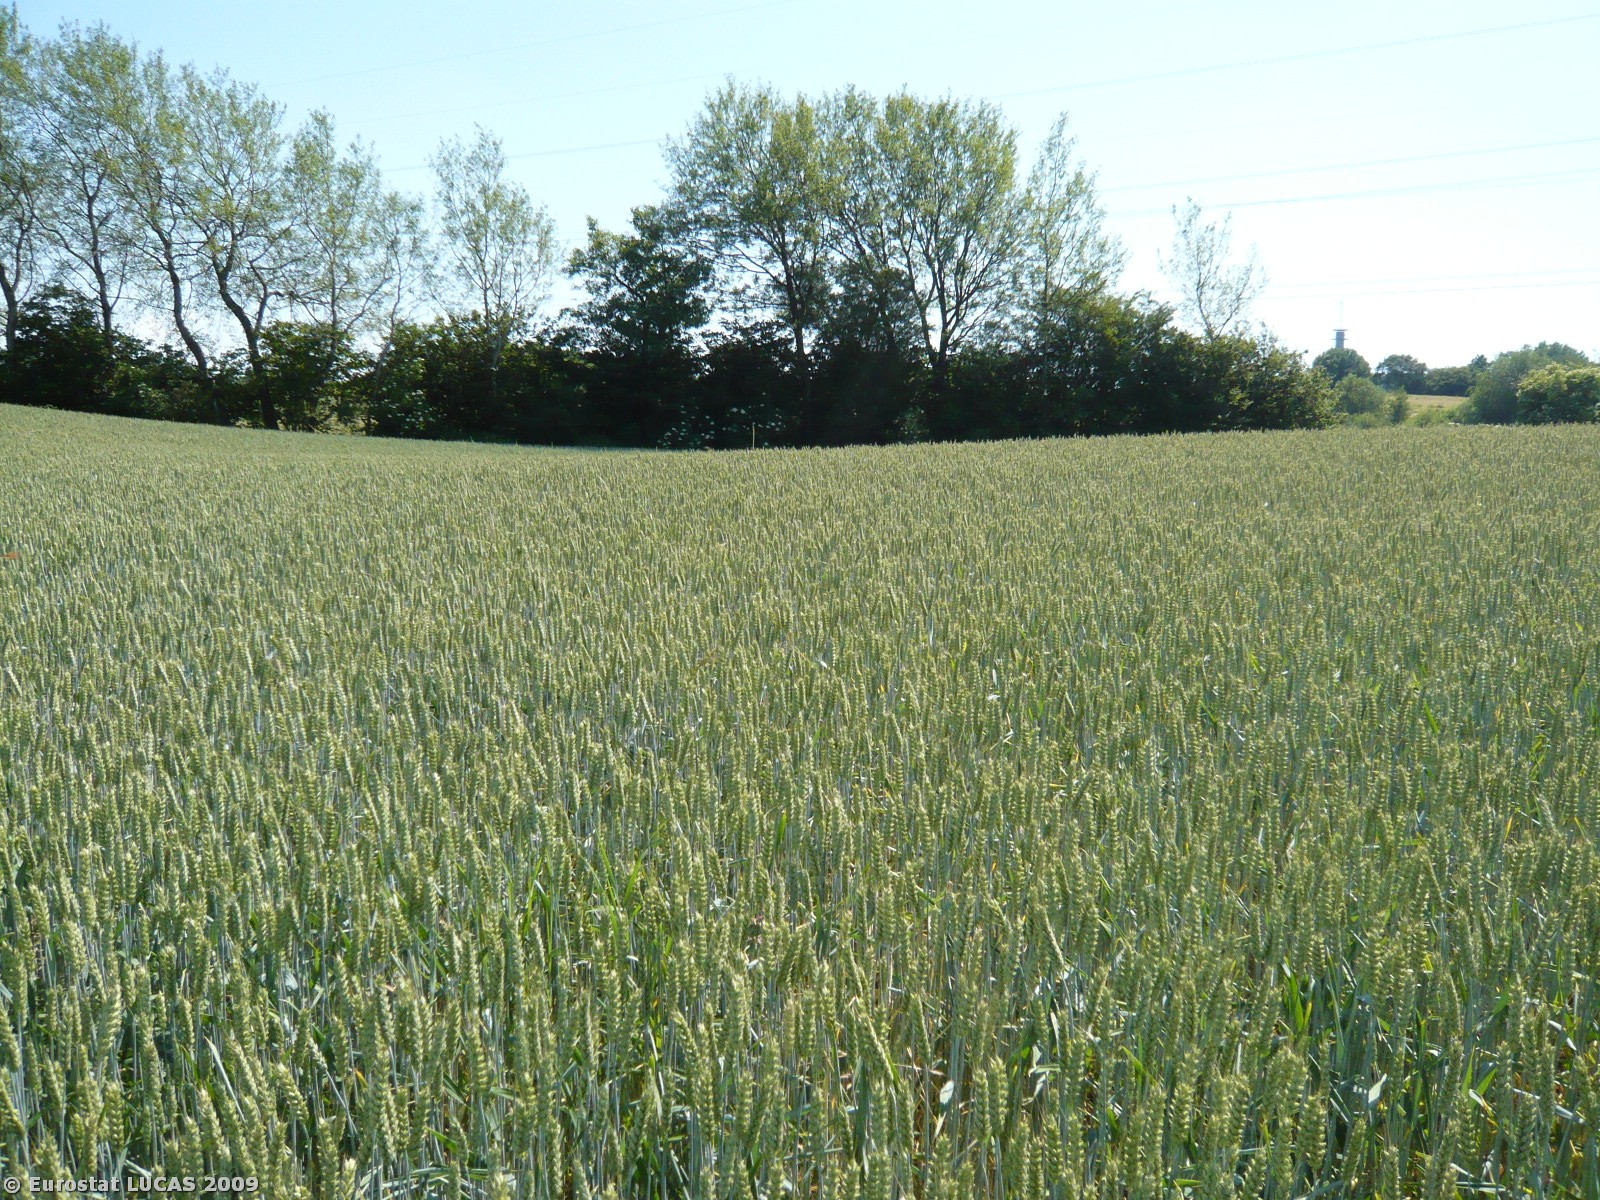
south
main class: Cropland
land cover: Common wheat
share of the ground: > 75 %
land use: Agriculture (excluding fallow land and kitchen gardens)
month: July
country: DK
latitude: 55.3968
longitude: 10.1420
